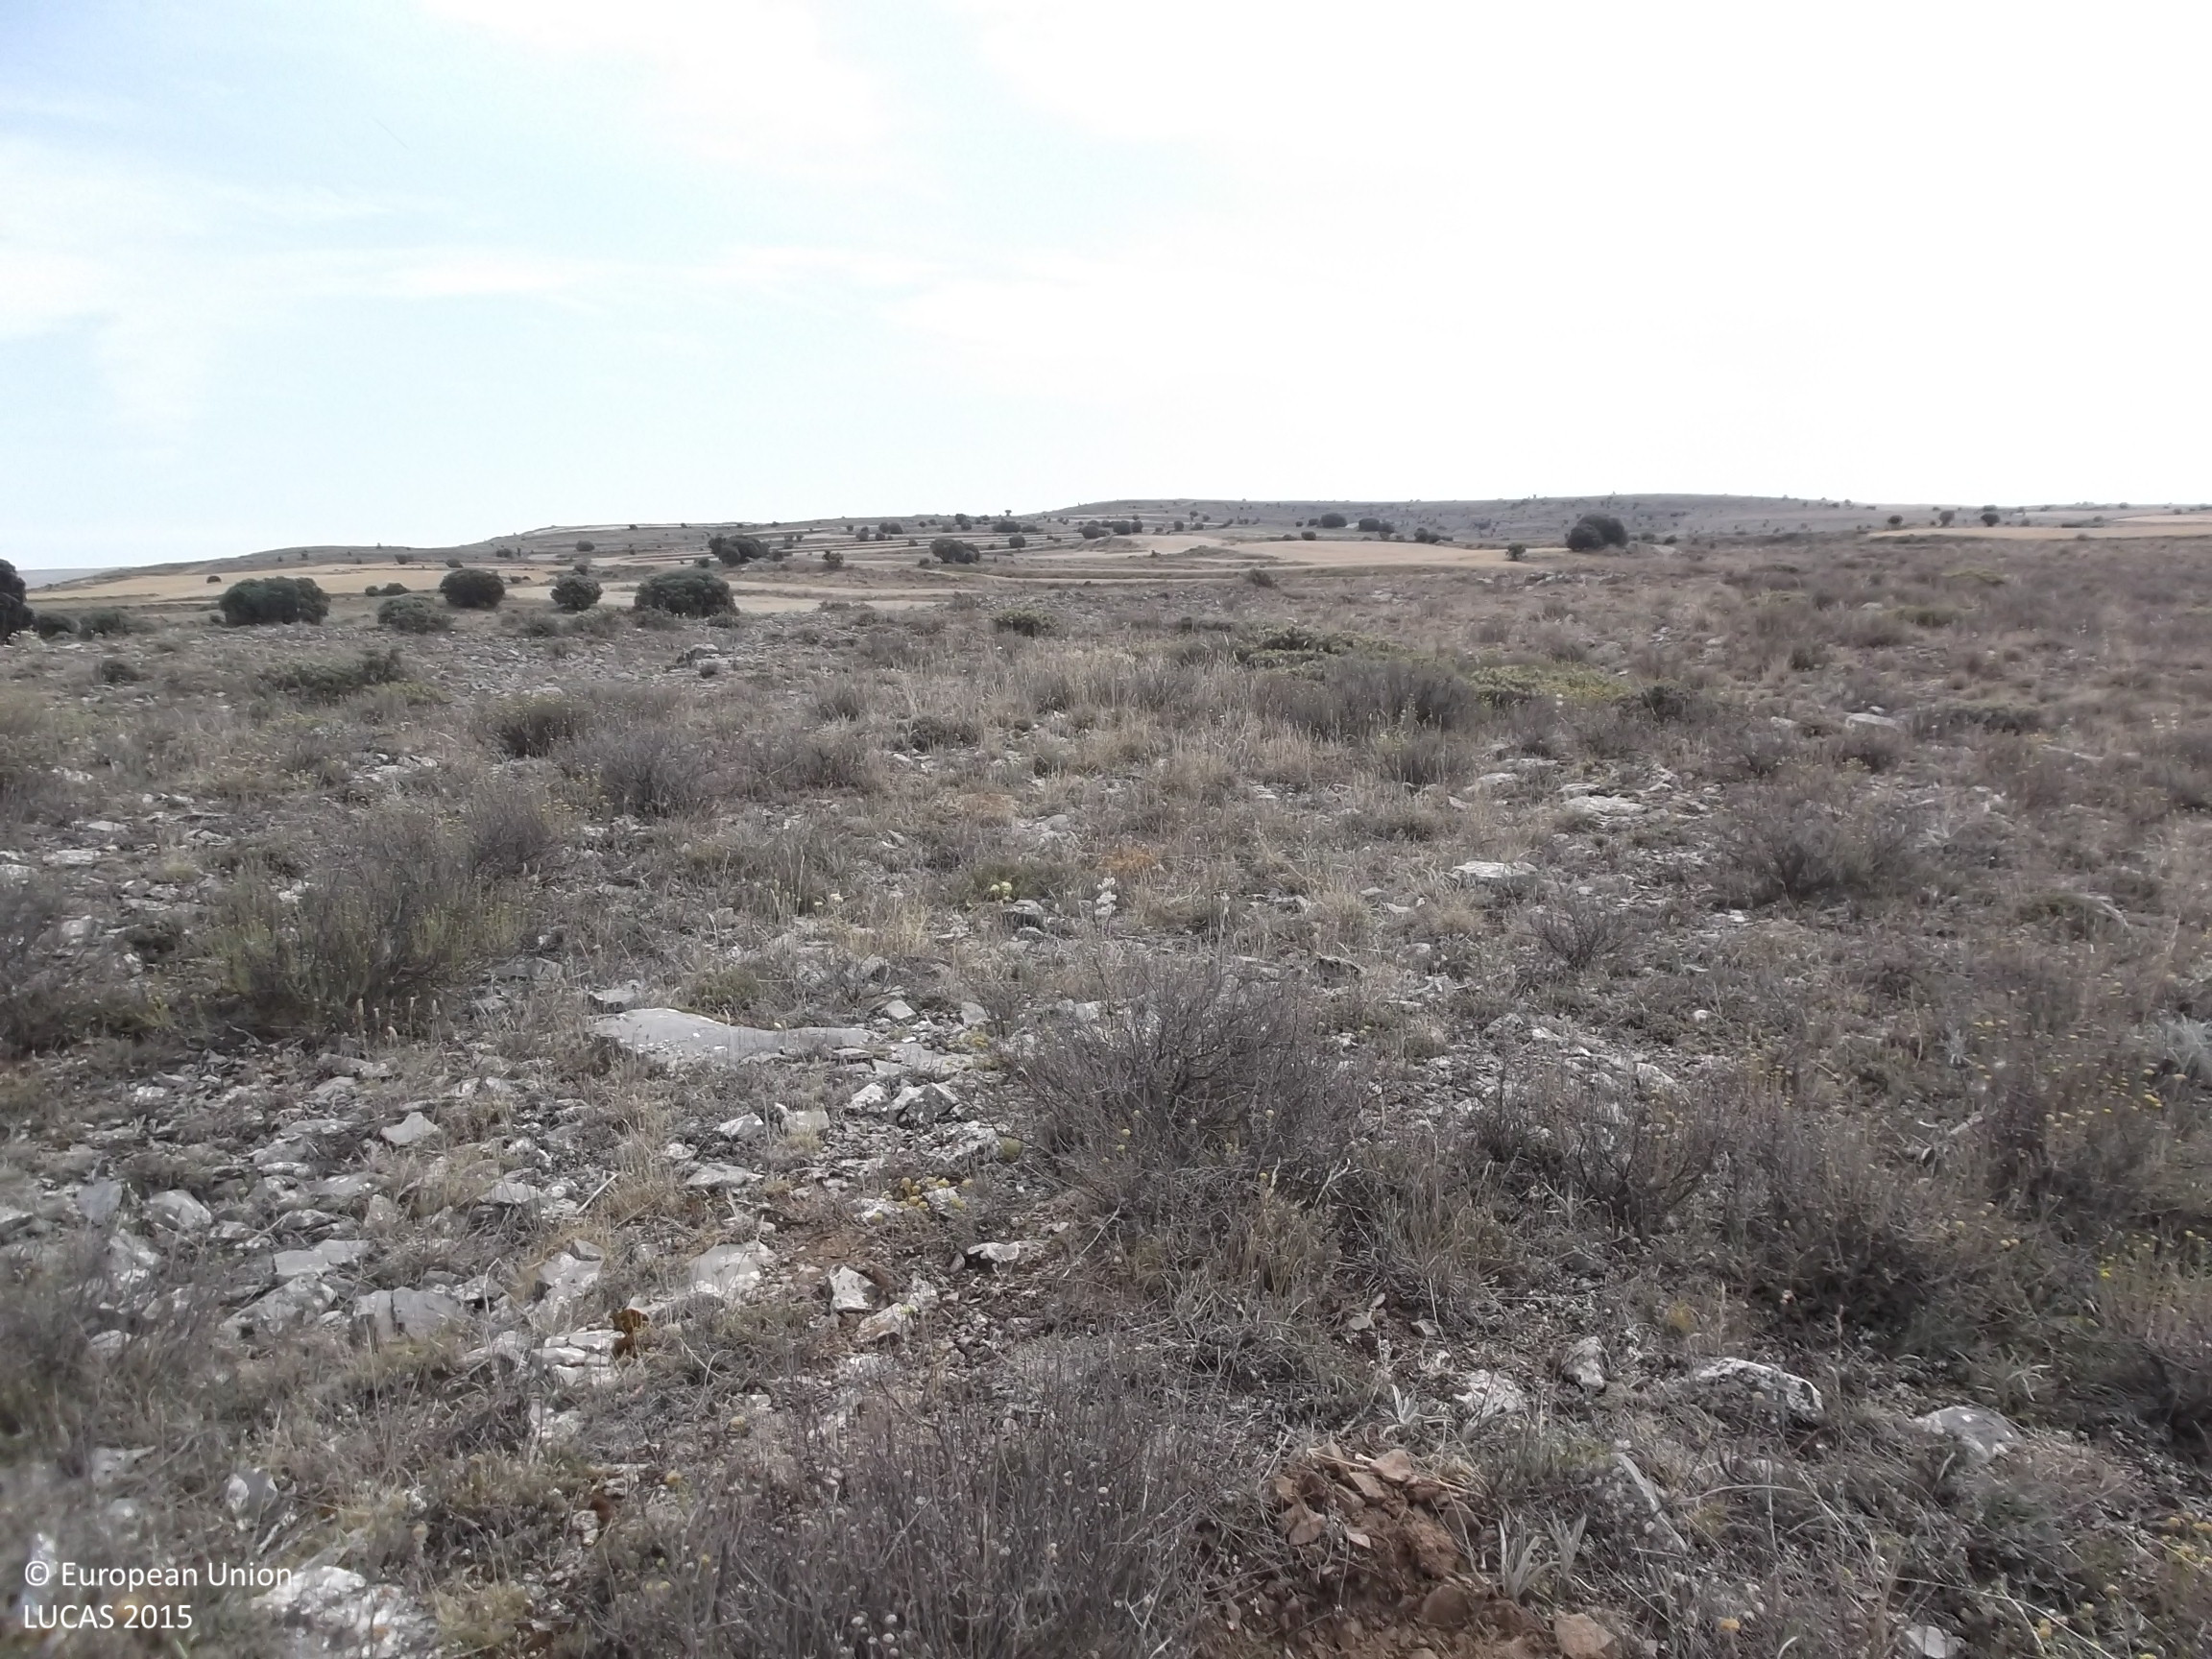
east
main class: Shrubland
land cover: Shrubland without tree cover
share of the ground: 50 - 75 %
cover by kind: shrubs 60 %, unconsolidated bare surface 30 %, herbaceous plants 10 %
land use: Semi-natural and natural areas not in use
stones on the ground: > 50 %
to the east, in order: Shrubland without tree cover; Tracks; Shrubland without tree cover; Common wheat; Shruby margins; Spontaneously vegetated surfaces; Shruby margins; Common wheat; Shruby margins; Common wheat; Shruby margins; Barley
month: July
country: ES
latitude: 41.8839
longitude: -2.2930
